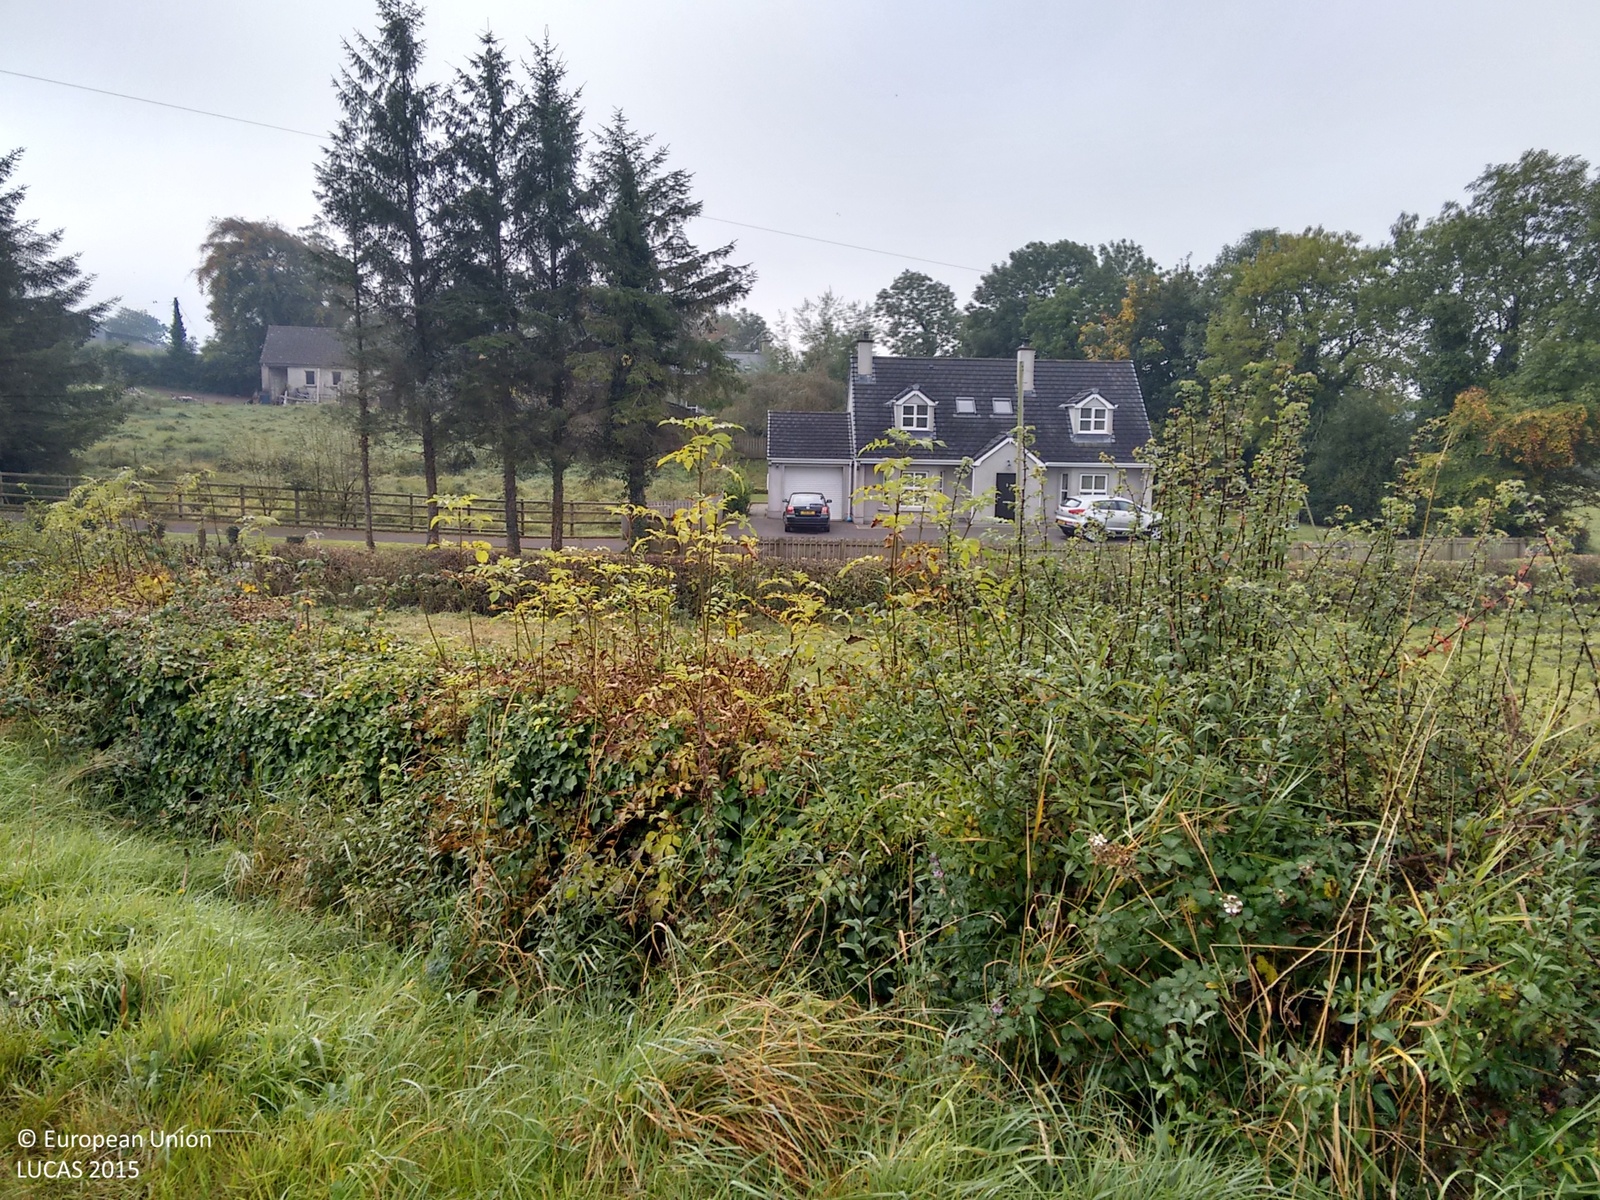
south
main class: Grassland
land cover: Grassland without tree/shrub cover
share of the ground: > 75 %
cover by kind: herbaceous plants 100 %
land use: Agriculture (excluding fallow land and kitchen gardens)
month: October
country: GB
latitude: 54.4438
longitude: -7.8231
